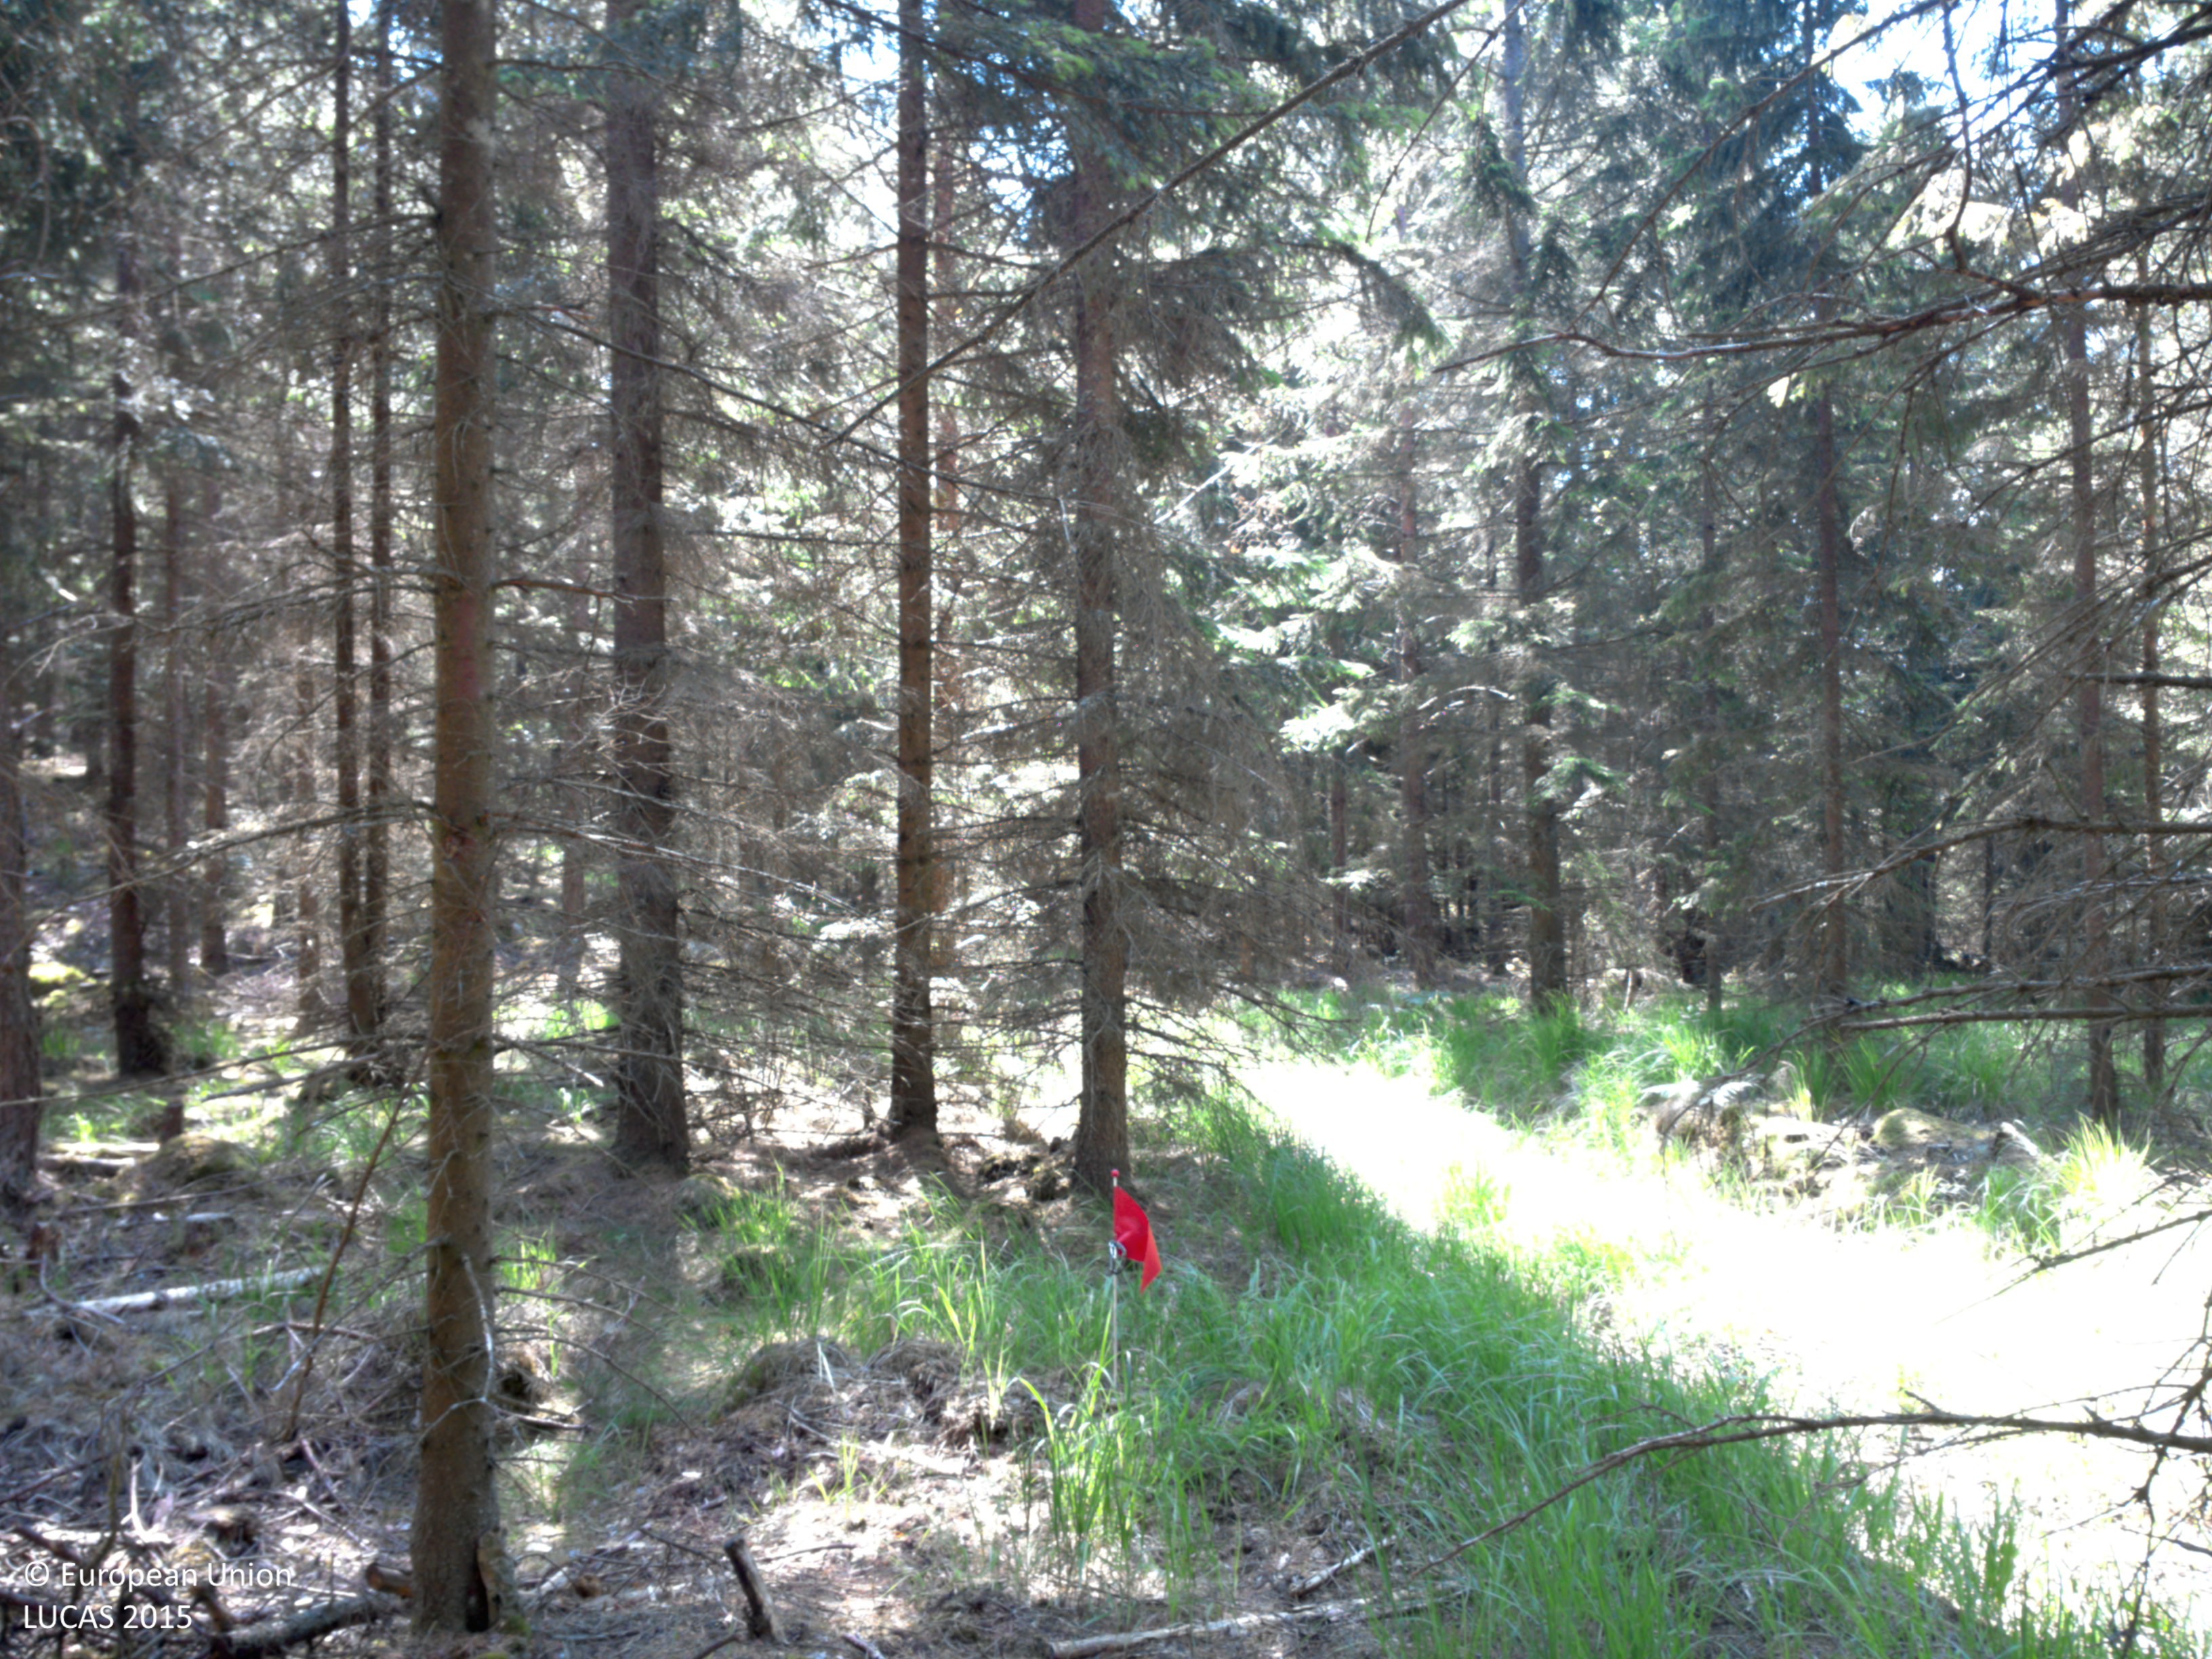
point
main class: Woodland
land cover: Spruce dominated coniferous woodland
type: boreal forest
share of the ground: 50 - 75 %
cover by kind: coniferous forest trees 50 %, herbaceous plants 30 %, lichens and mosses 20 %
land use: Forestry
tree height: > 5 m
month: July
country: SE
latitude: 57.9118
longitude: 12.3083
